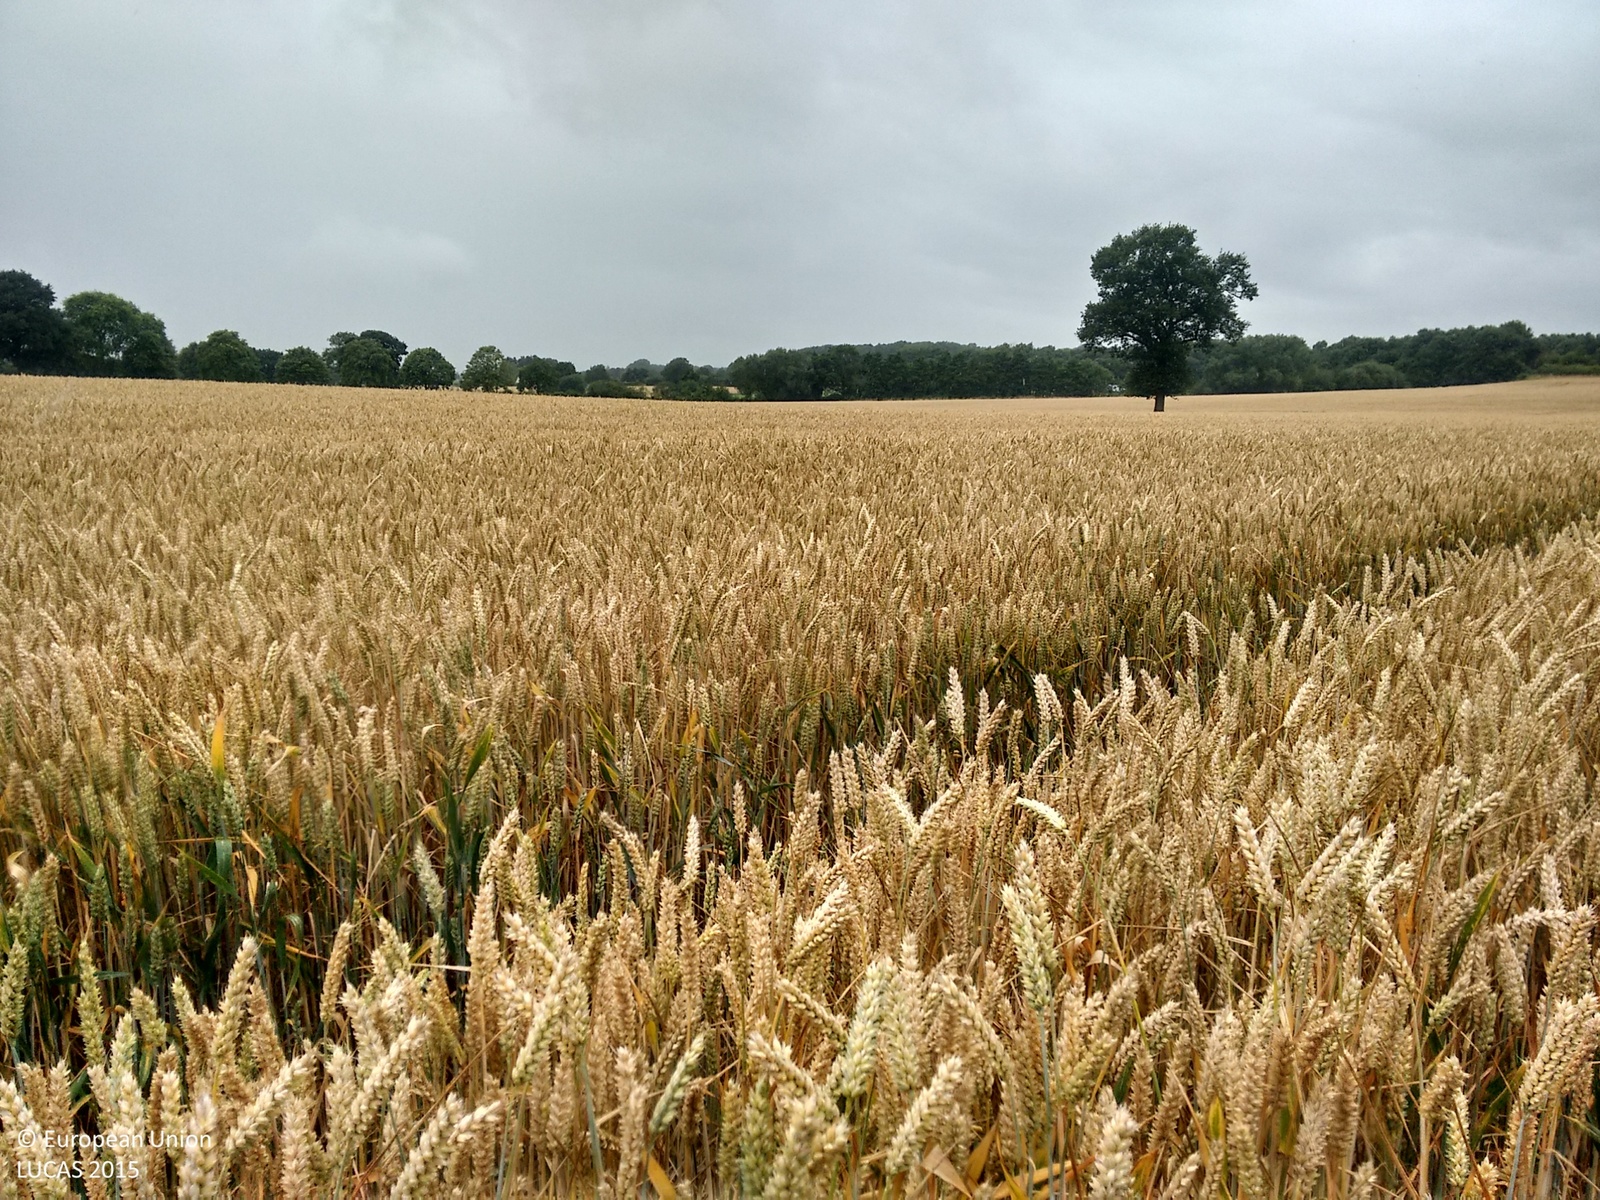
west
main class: Cropland
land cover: Common wheat
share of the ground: > 75 %
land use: Agriculture (excluding fallow land and kitchen gardens)
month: July
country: GB
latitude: 52.6491
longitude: -2.2565
